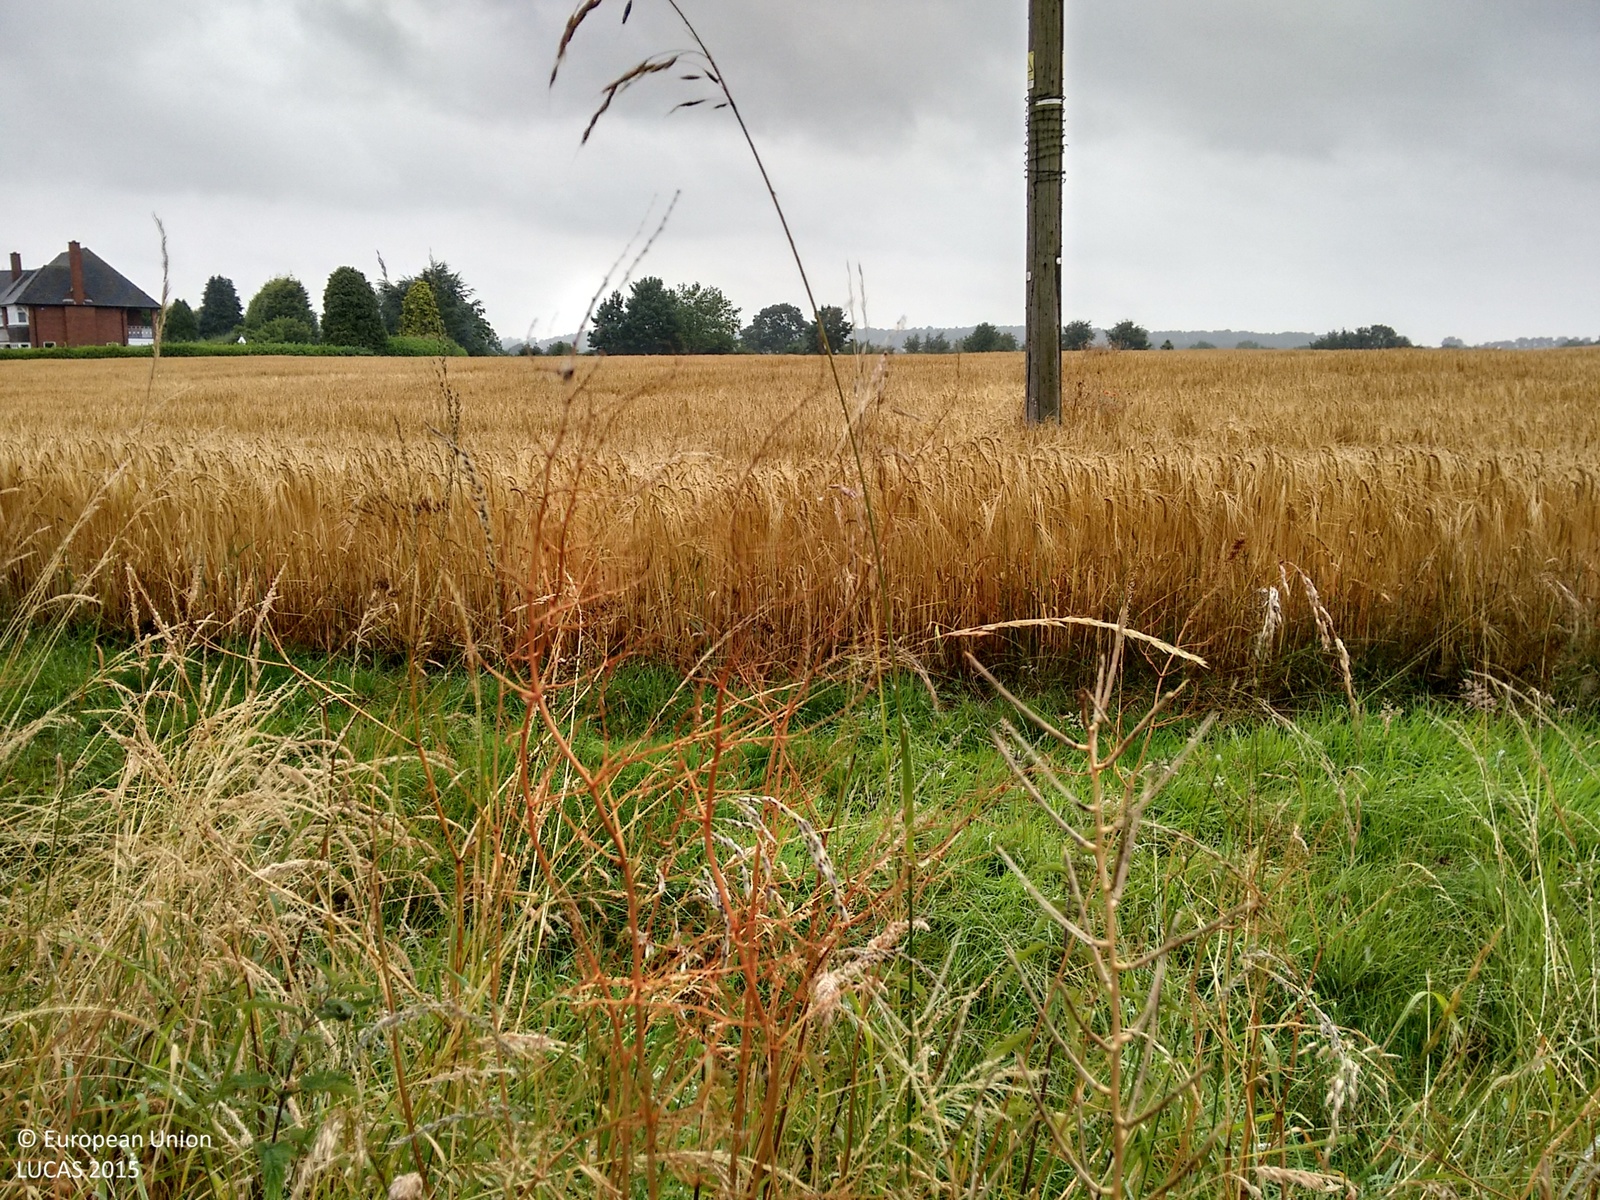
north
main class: Cropland
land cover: Barley
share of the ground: > 75 %
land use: Agriculture (excluding fallow land and kitchen gardens)
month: July
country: GB
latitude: 52.5223
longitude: -2.2507
